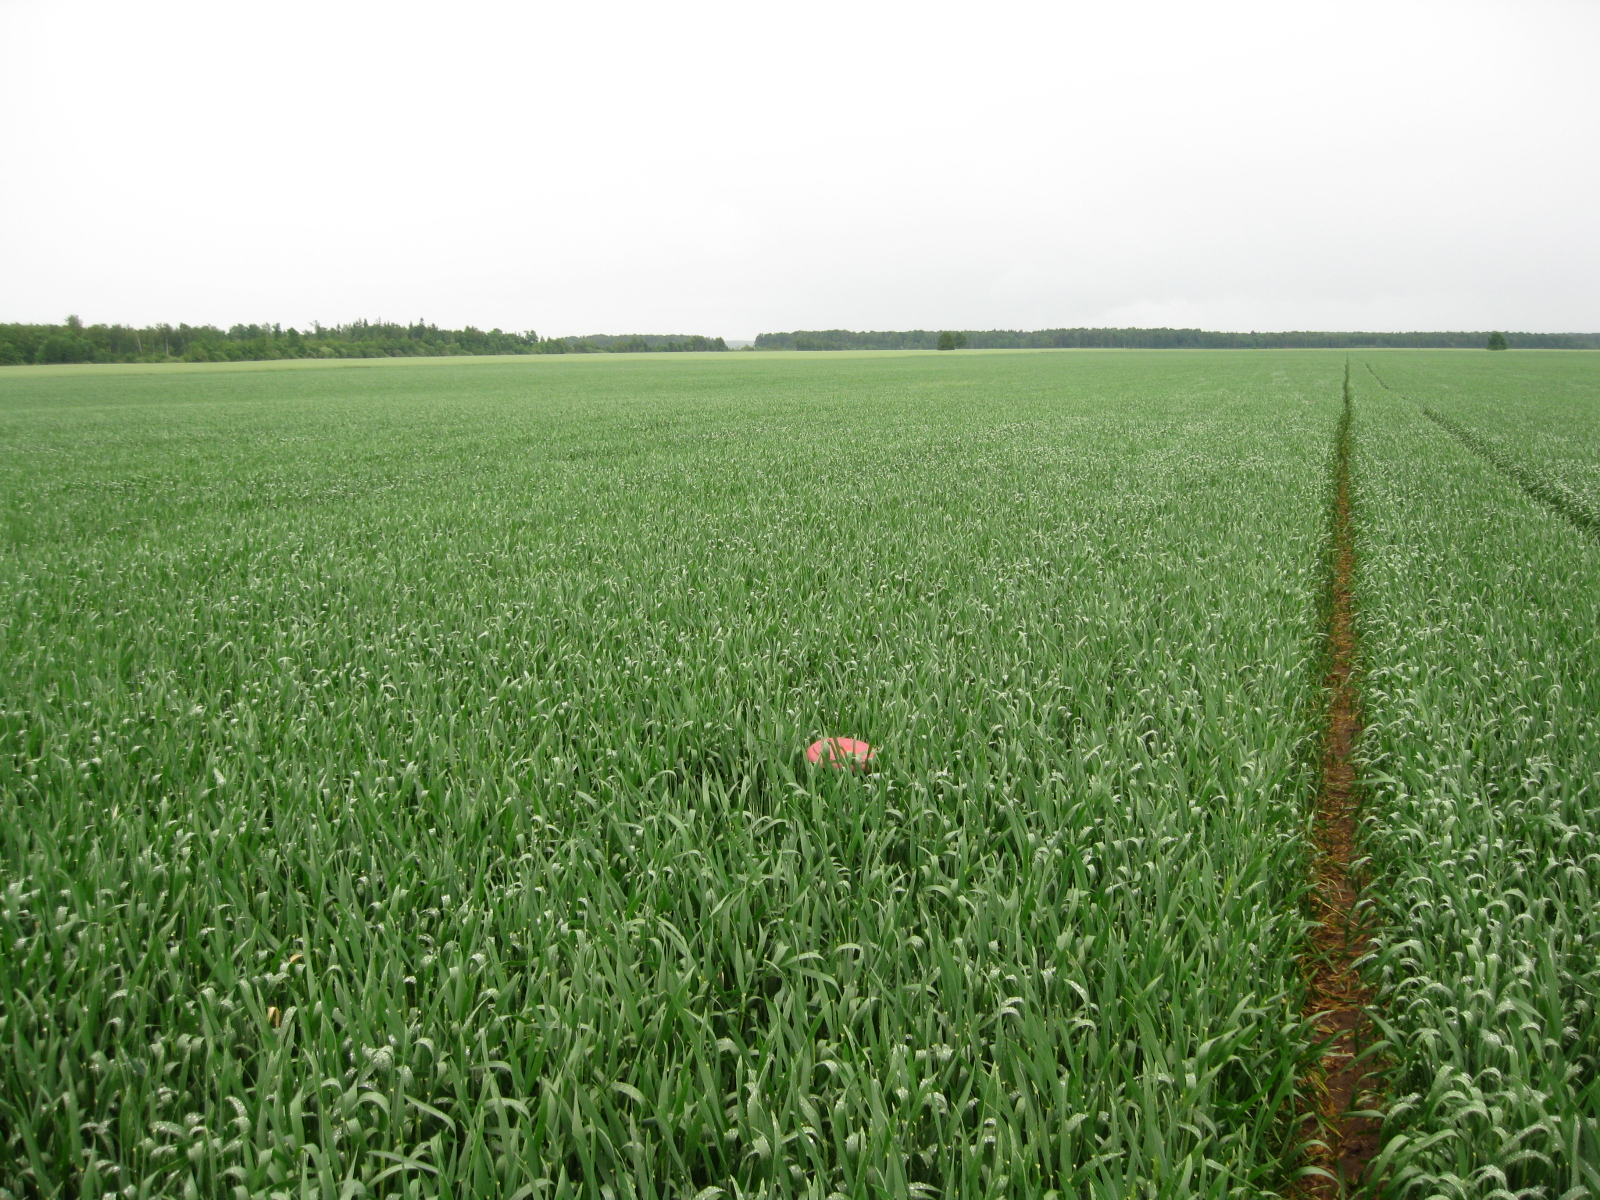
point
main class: Cropland
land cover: Common wheat
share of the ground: > 75 %
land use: Agriculture (excluding fallow land and kitchen gardens)
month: June
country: LT
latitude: 55.4492
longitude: 23.8572
